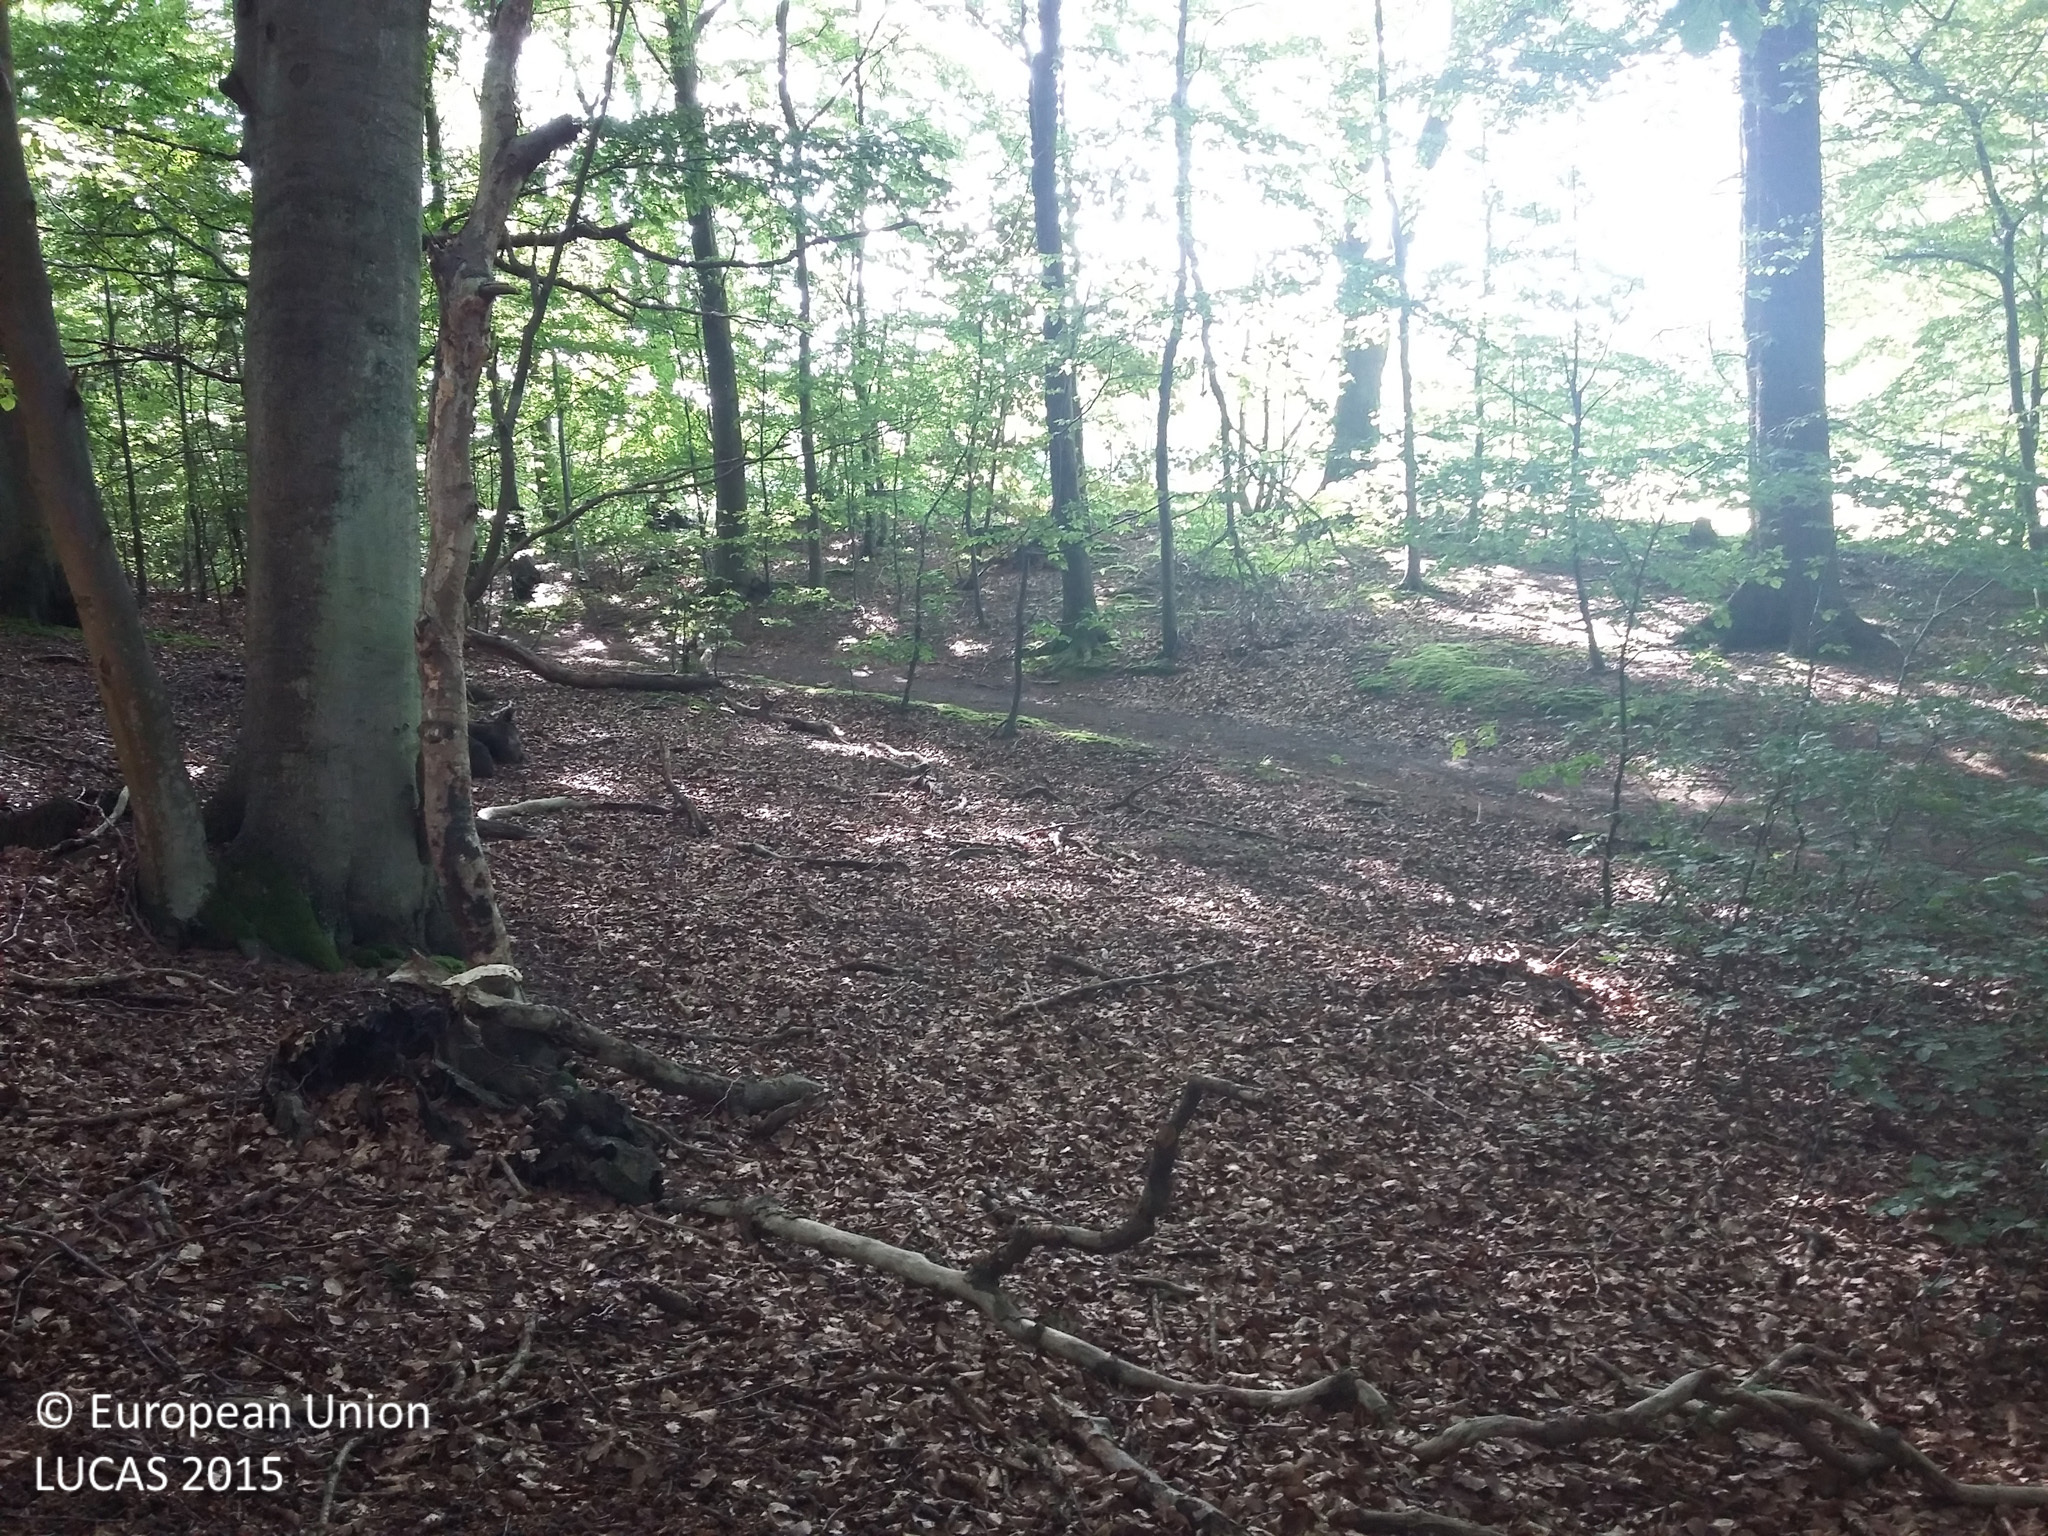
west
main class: Woodland
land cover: Broadleaved woodland
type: beech forest
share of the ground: > 75 %
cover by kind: broadleaved forest trees 95 %, herbaceous plants 5 %
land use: Amenities, museums, leisure
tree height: > 5 m
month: July
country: DK
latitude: 56.0539
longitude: 12.5829
